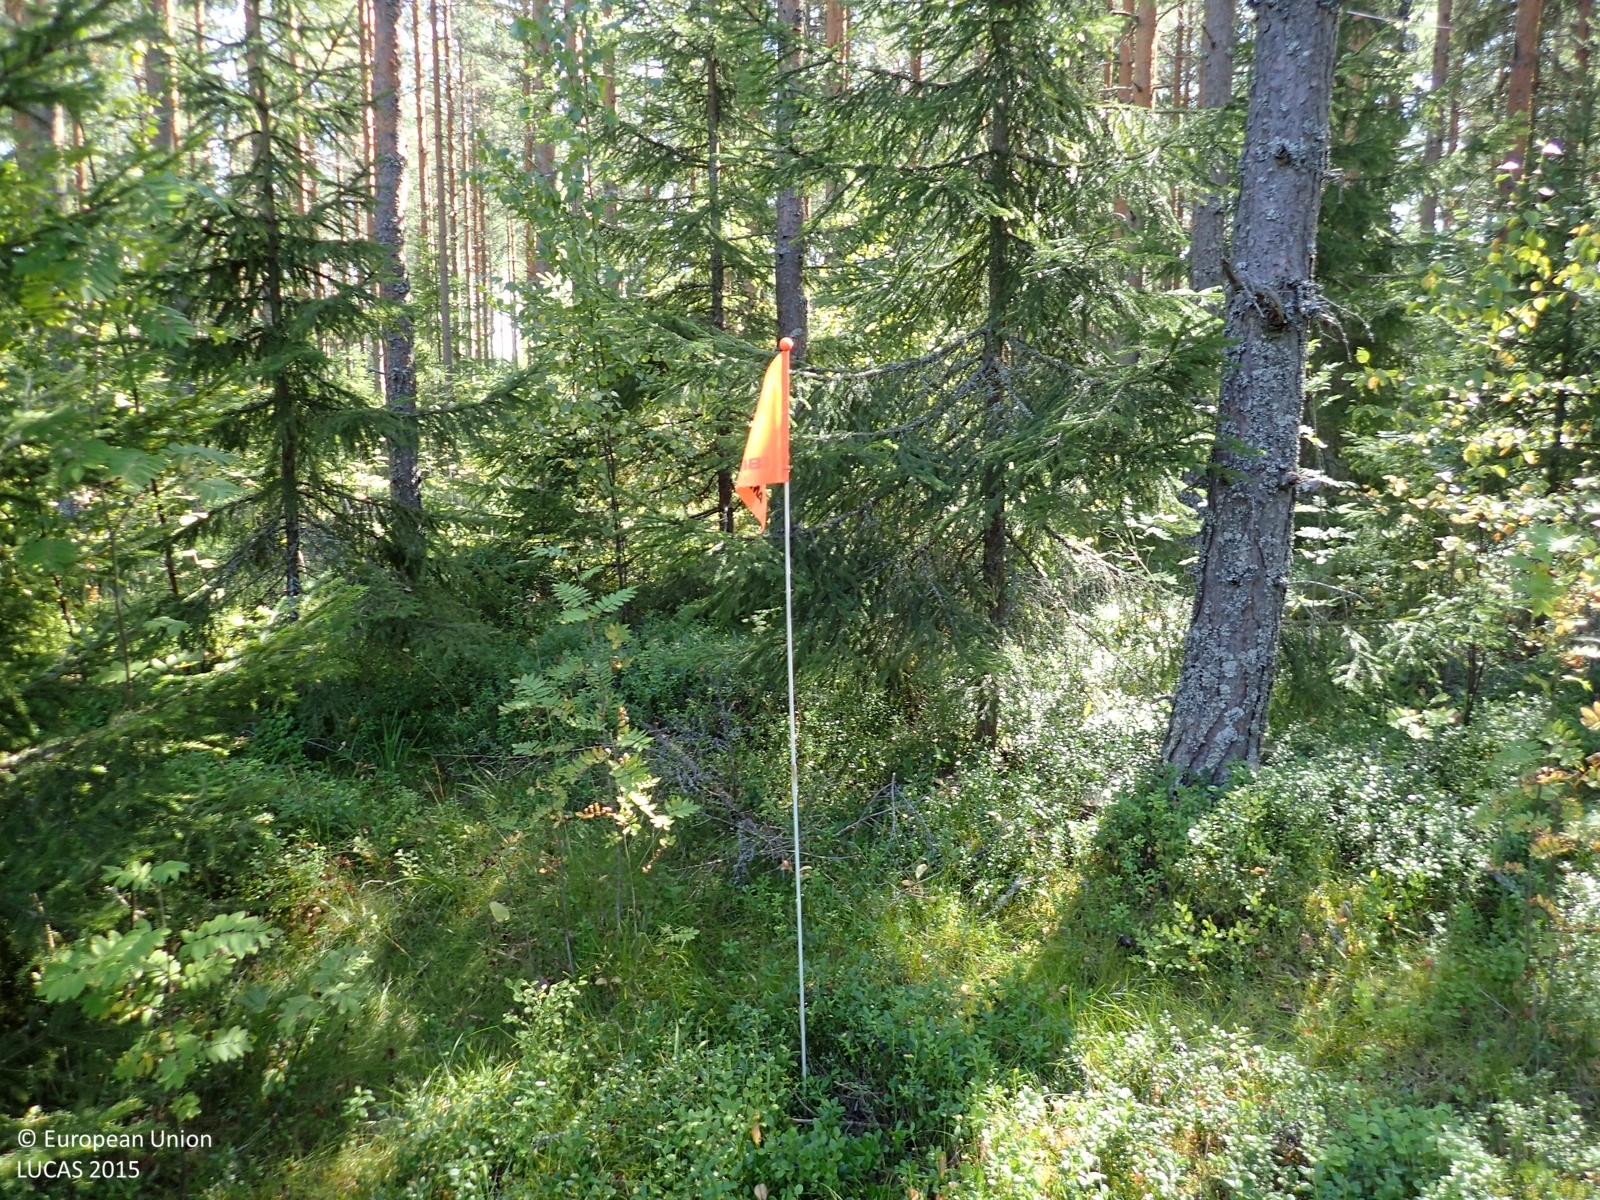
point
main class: Woodland
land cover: Pine dominated coniferous woodland
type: boreal forest
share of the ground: > 75 %
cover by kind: coniferous forest trees 70 %, shrubs 20 %, broadleaved forest trees 5 %, herbaceous plants 5 %
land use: Forestry
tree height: > 5 m
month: August
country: FI
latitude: 62.5863
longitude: 21.7856
